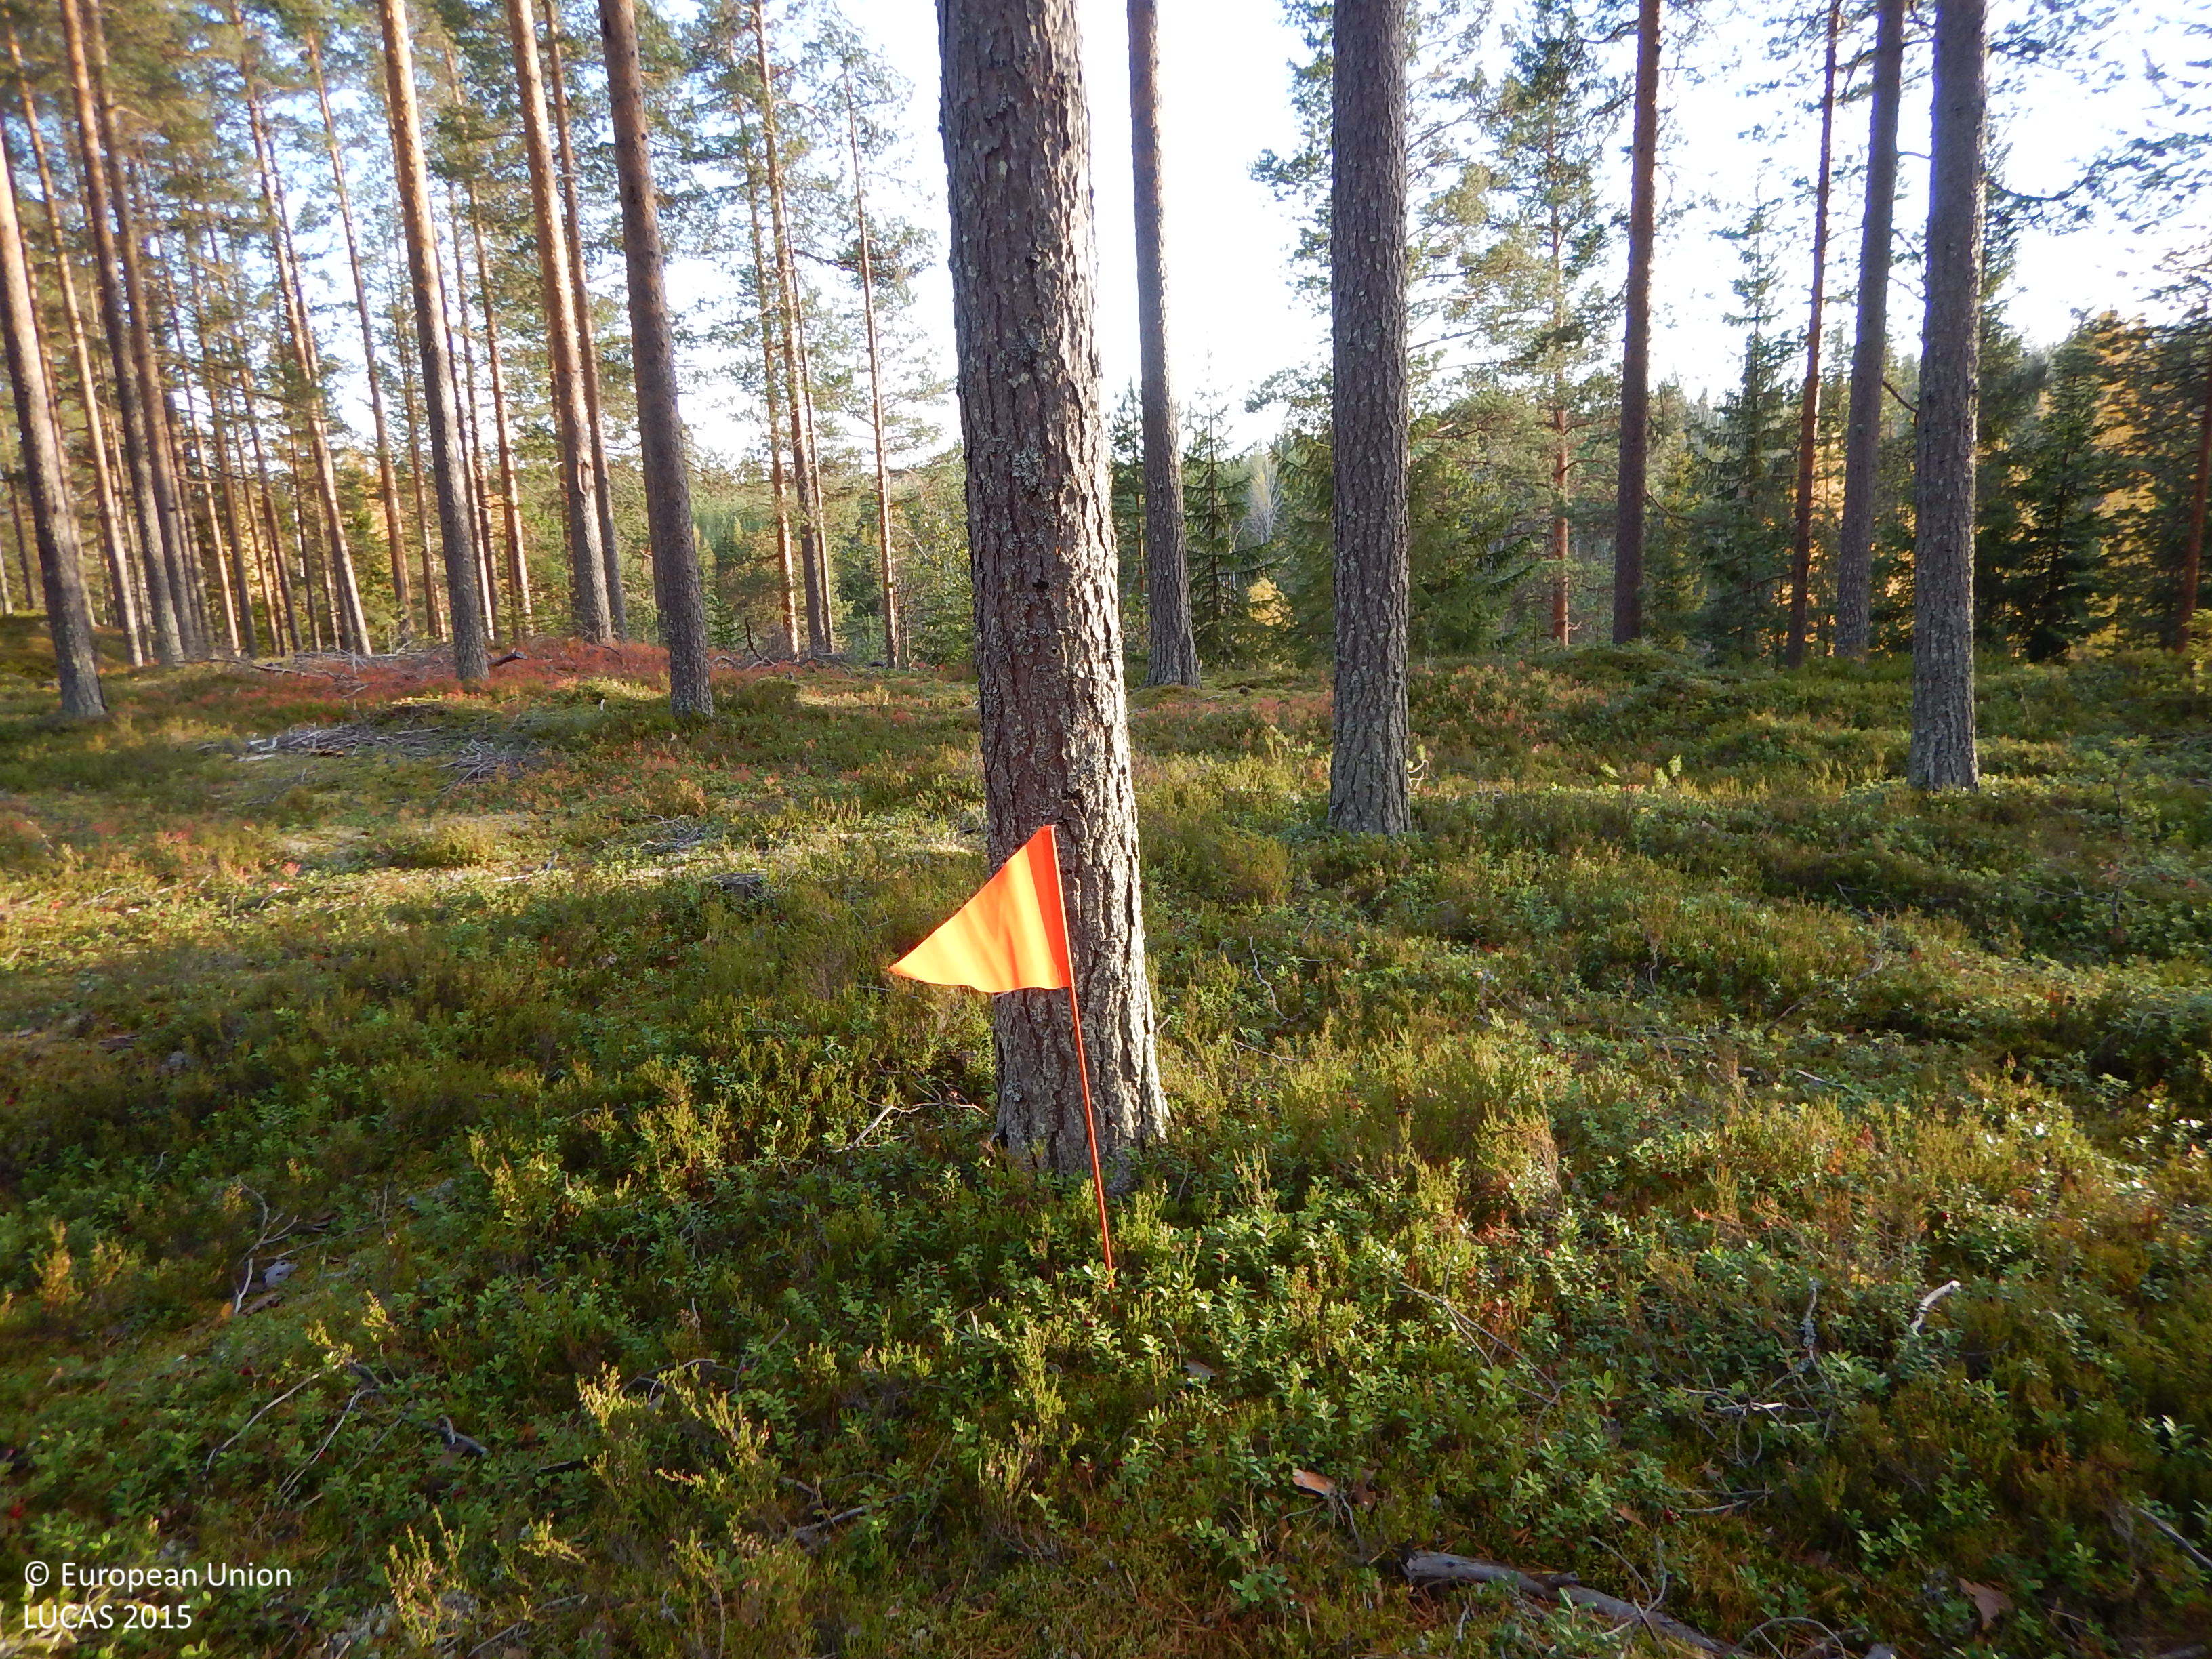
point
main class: Woodland
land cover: Pine dominated coniferous woodland
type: boreal forest
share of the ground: 50 - 75 %
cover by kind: coniferous forest trees 55 %, shrubs 25 %, lichens and mosses 15 %, herbaceous plants 5 %
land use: Forestry
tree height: > 5 m
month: October
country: SE
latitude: 64.9607
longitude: 20.7953
